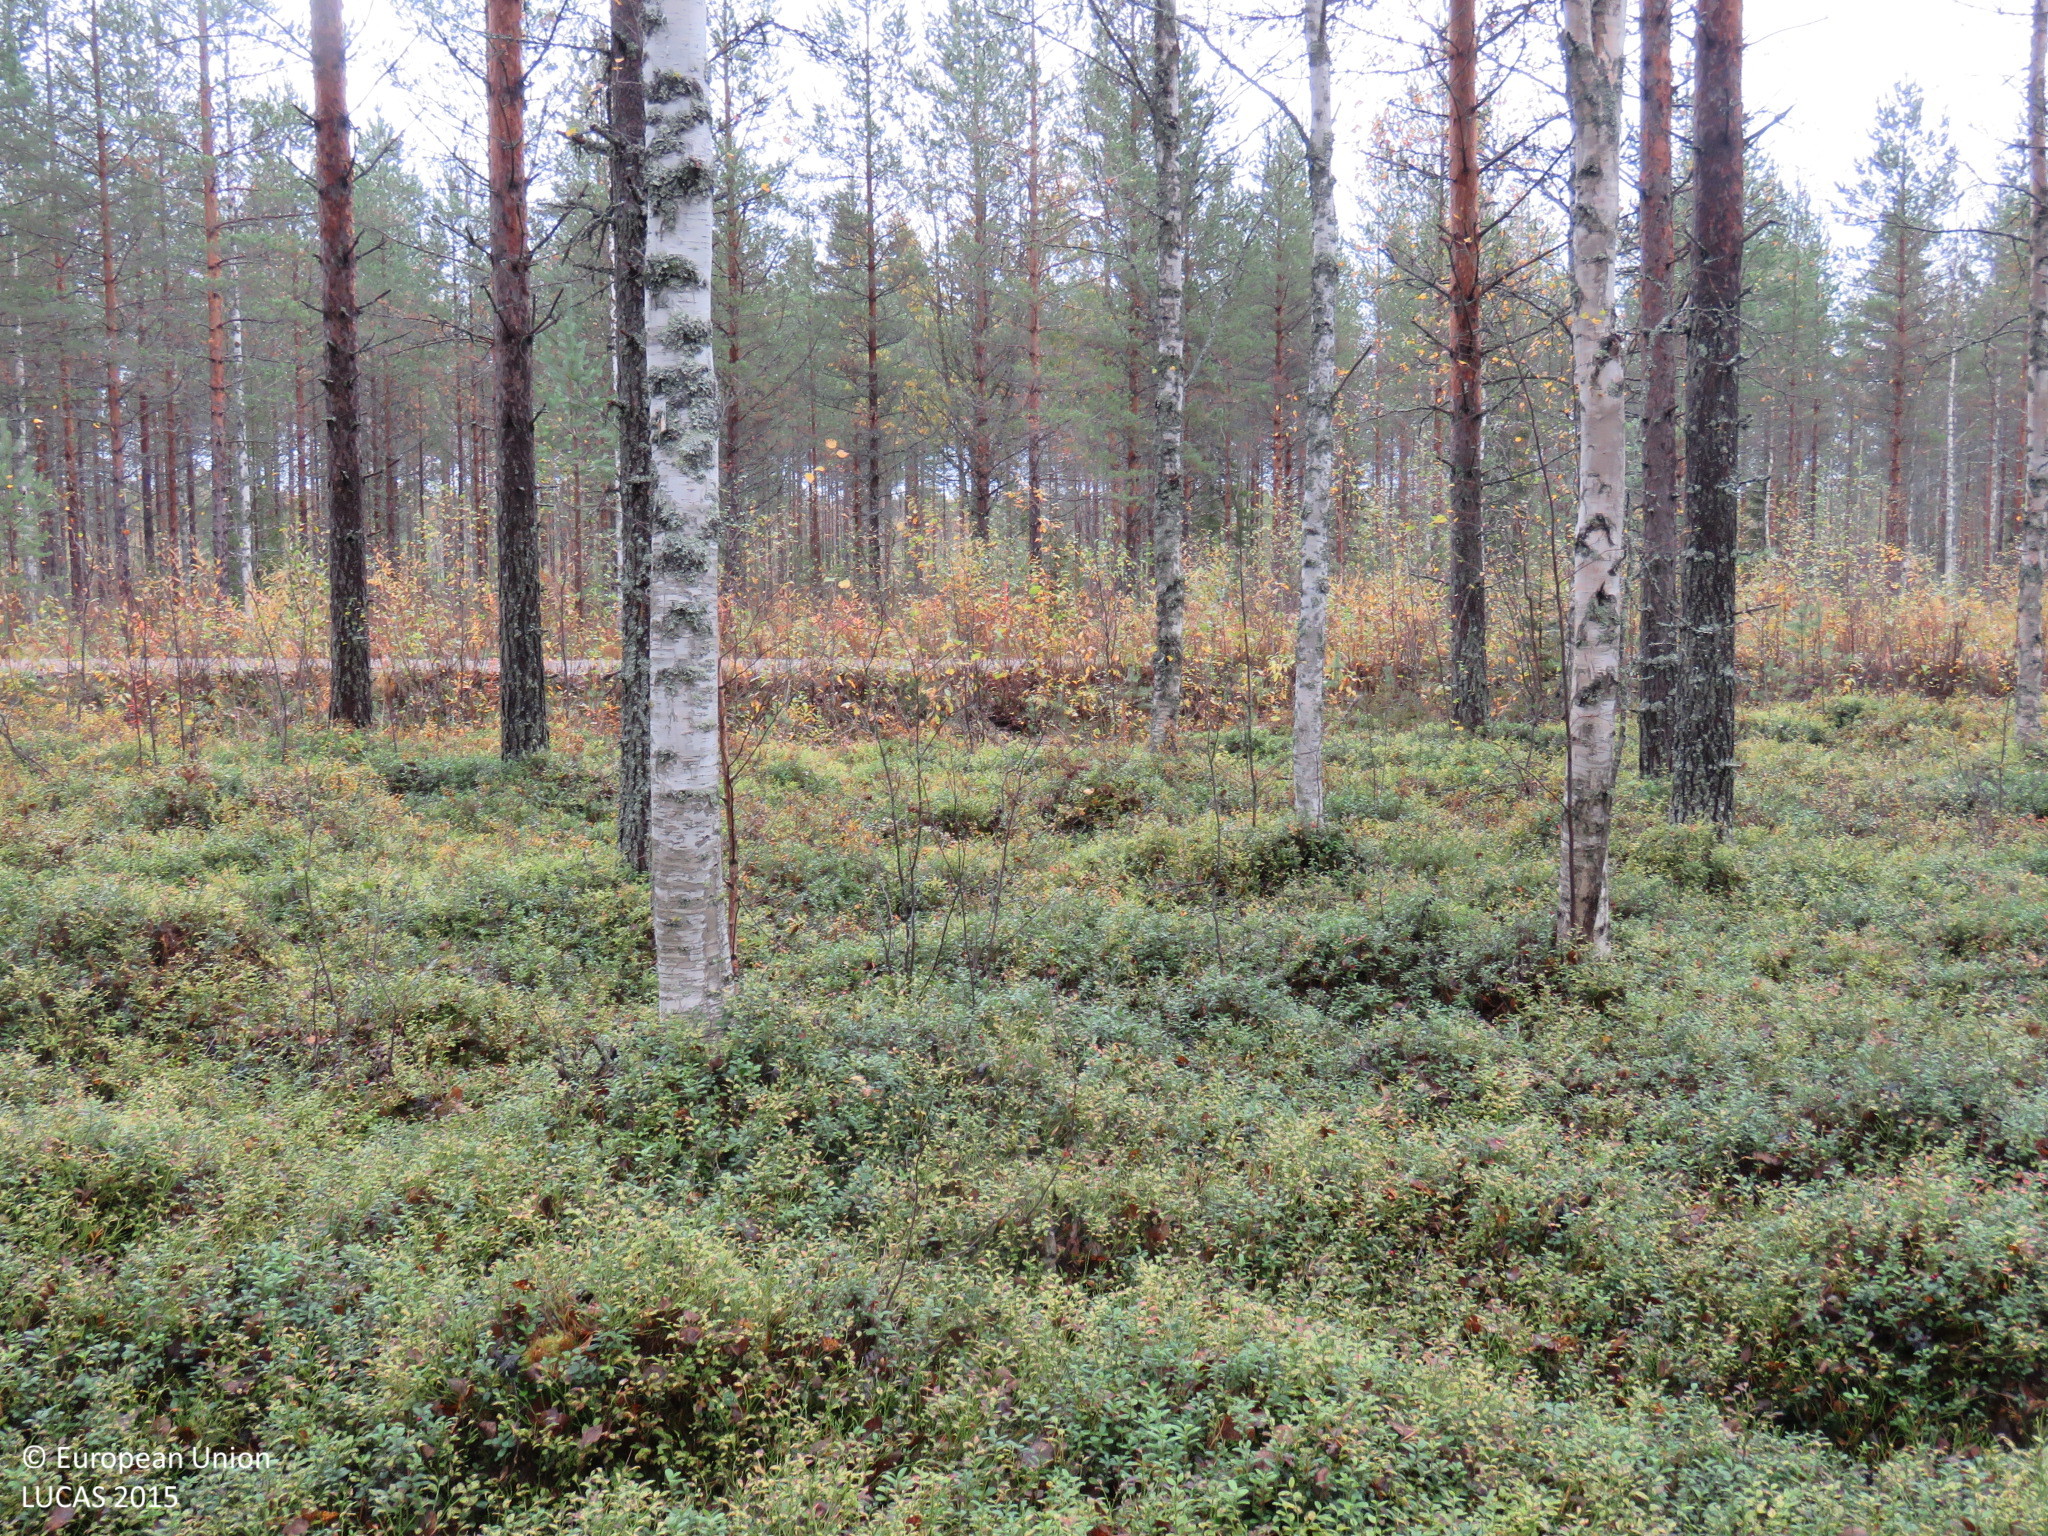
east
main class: Woodland
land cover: Pine dominated mixed woodland
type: boreal forest
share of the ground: 50 - 75 %
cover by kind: broadleaved forest trees 40 %, coniferous forest trees 30 %, shrubs 20 %, herbaceous plants 5 %, lichens and mosses 5 %
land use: Forestry
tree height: > 5 m
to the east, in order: Pine dominated mixed woodland; Ditches and canals; Abandoned hedges; Tracks; Abandoned hedges; Ditches and canals; Pine dominated mixed woodland; Pine dominated coniferous woodland; Shrubland with sparse tree cover; Pine dominated coniferous woodland; Pine dominated mixed woodland; Ditches and canals; Abandoned hedges; Tracks; Abandoned hedges; Ditches and canals; Pine dominated mixed woodland
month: September
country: FI
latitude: 64.8787
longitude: 26.8604
